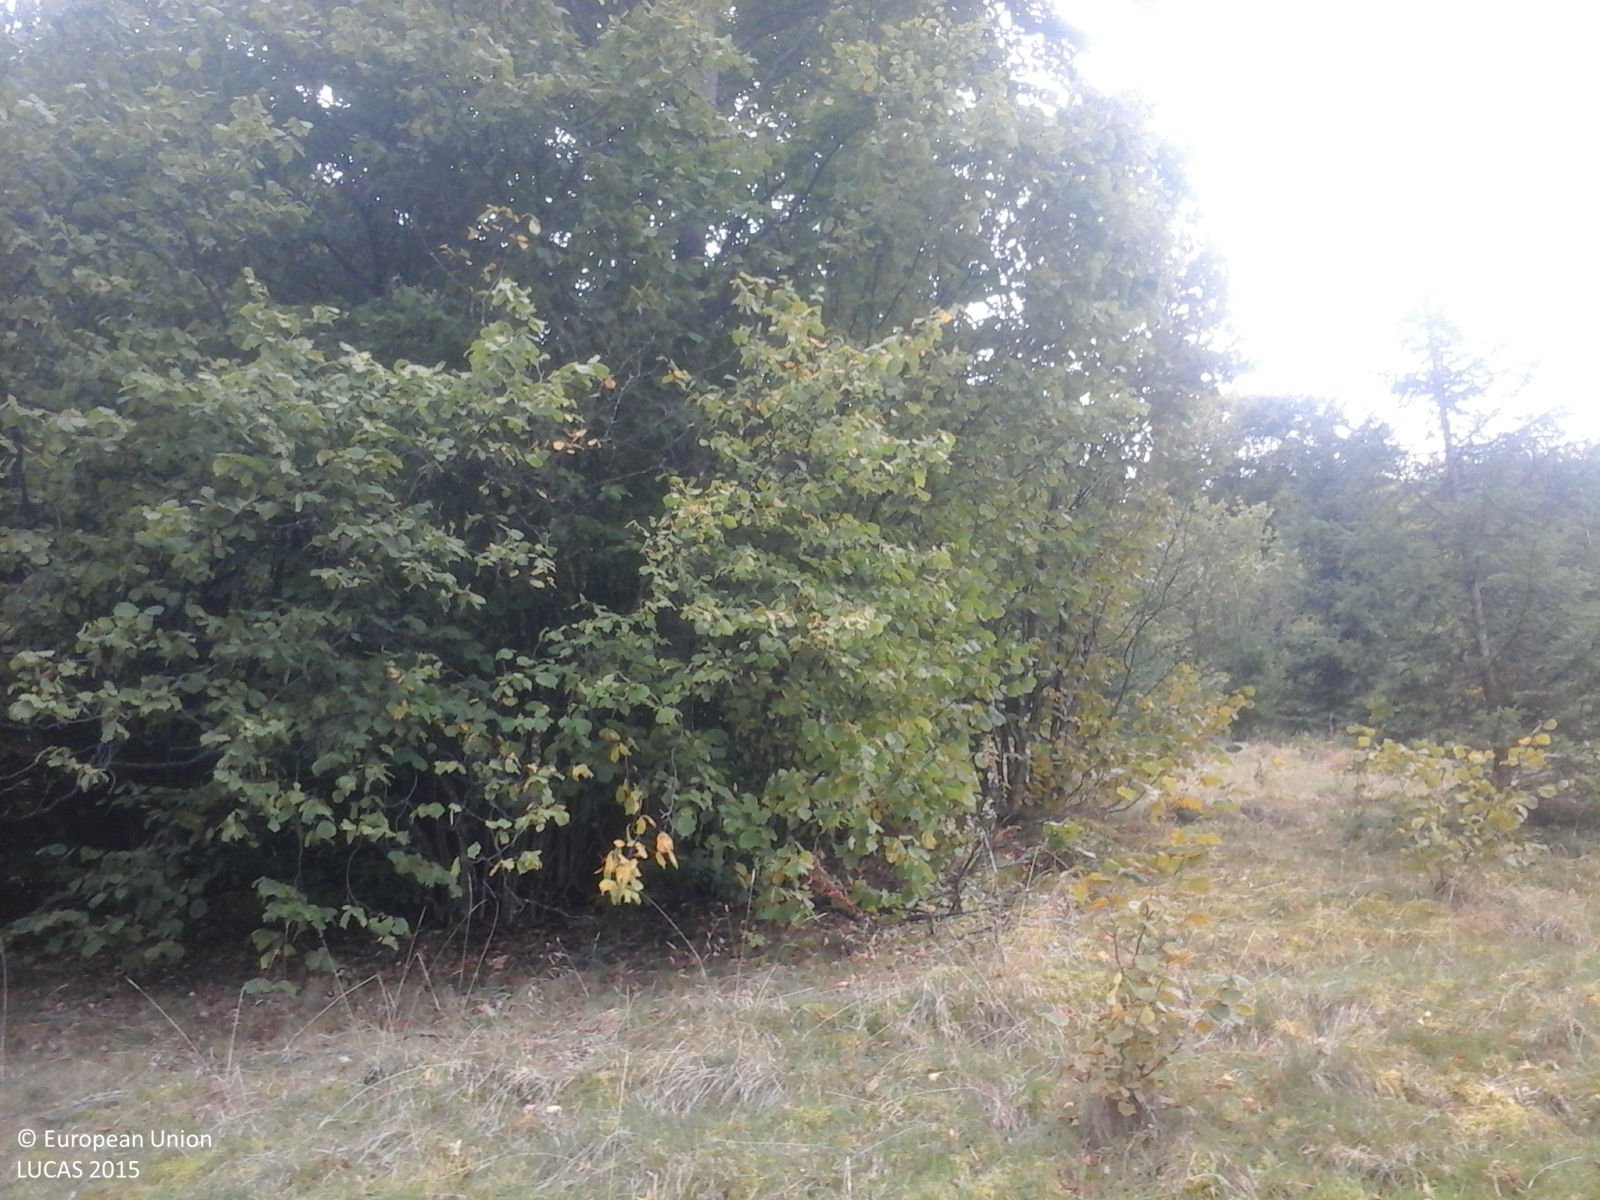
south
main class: Woodland
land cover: Other mixed woodland
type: beech forest
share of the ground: > 75 %
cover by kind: herbaceous plants 40 %, broadleaved forest trees 35 %, coniferous forest trees 25 %
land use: Forestry
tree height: > 5 m
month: September
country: RO
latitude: 46.6979
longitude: 22.8879
